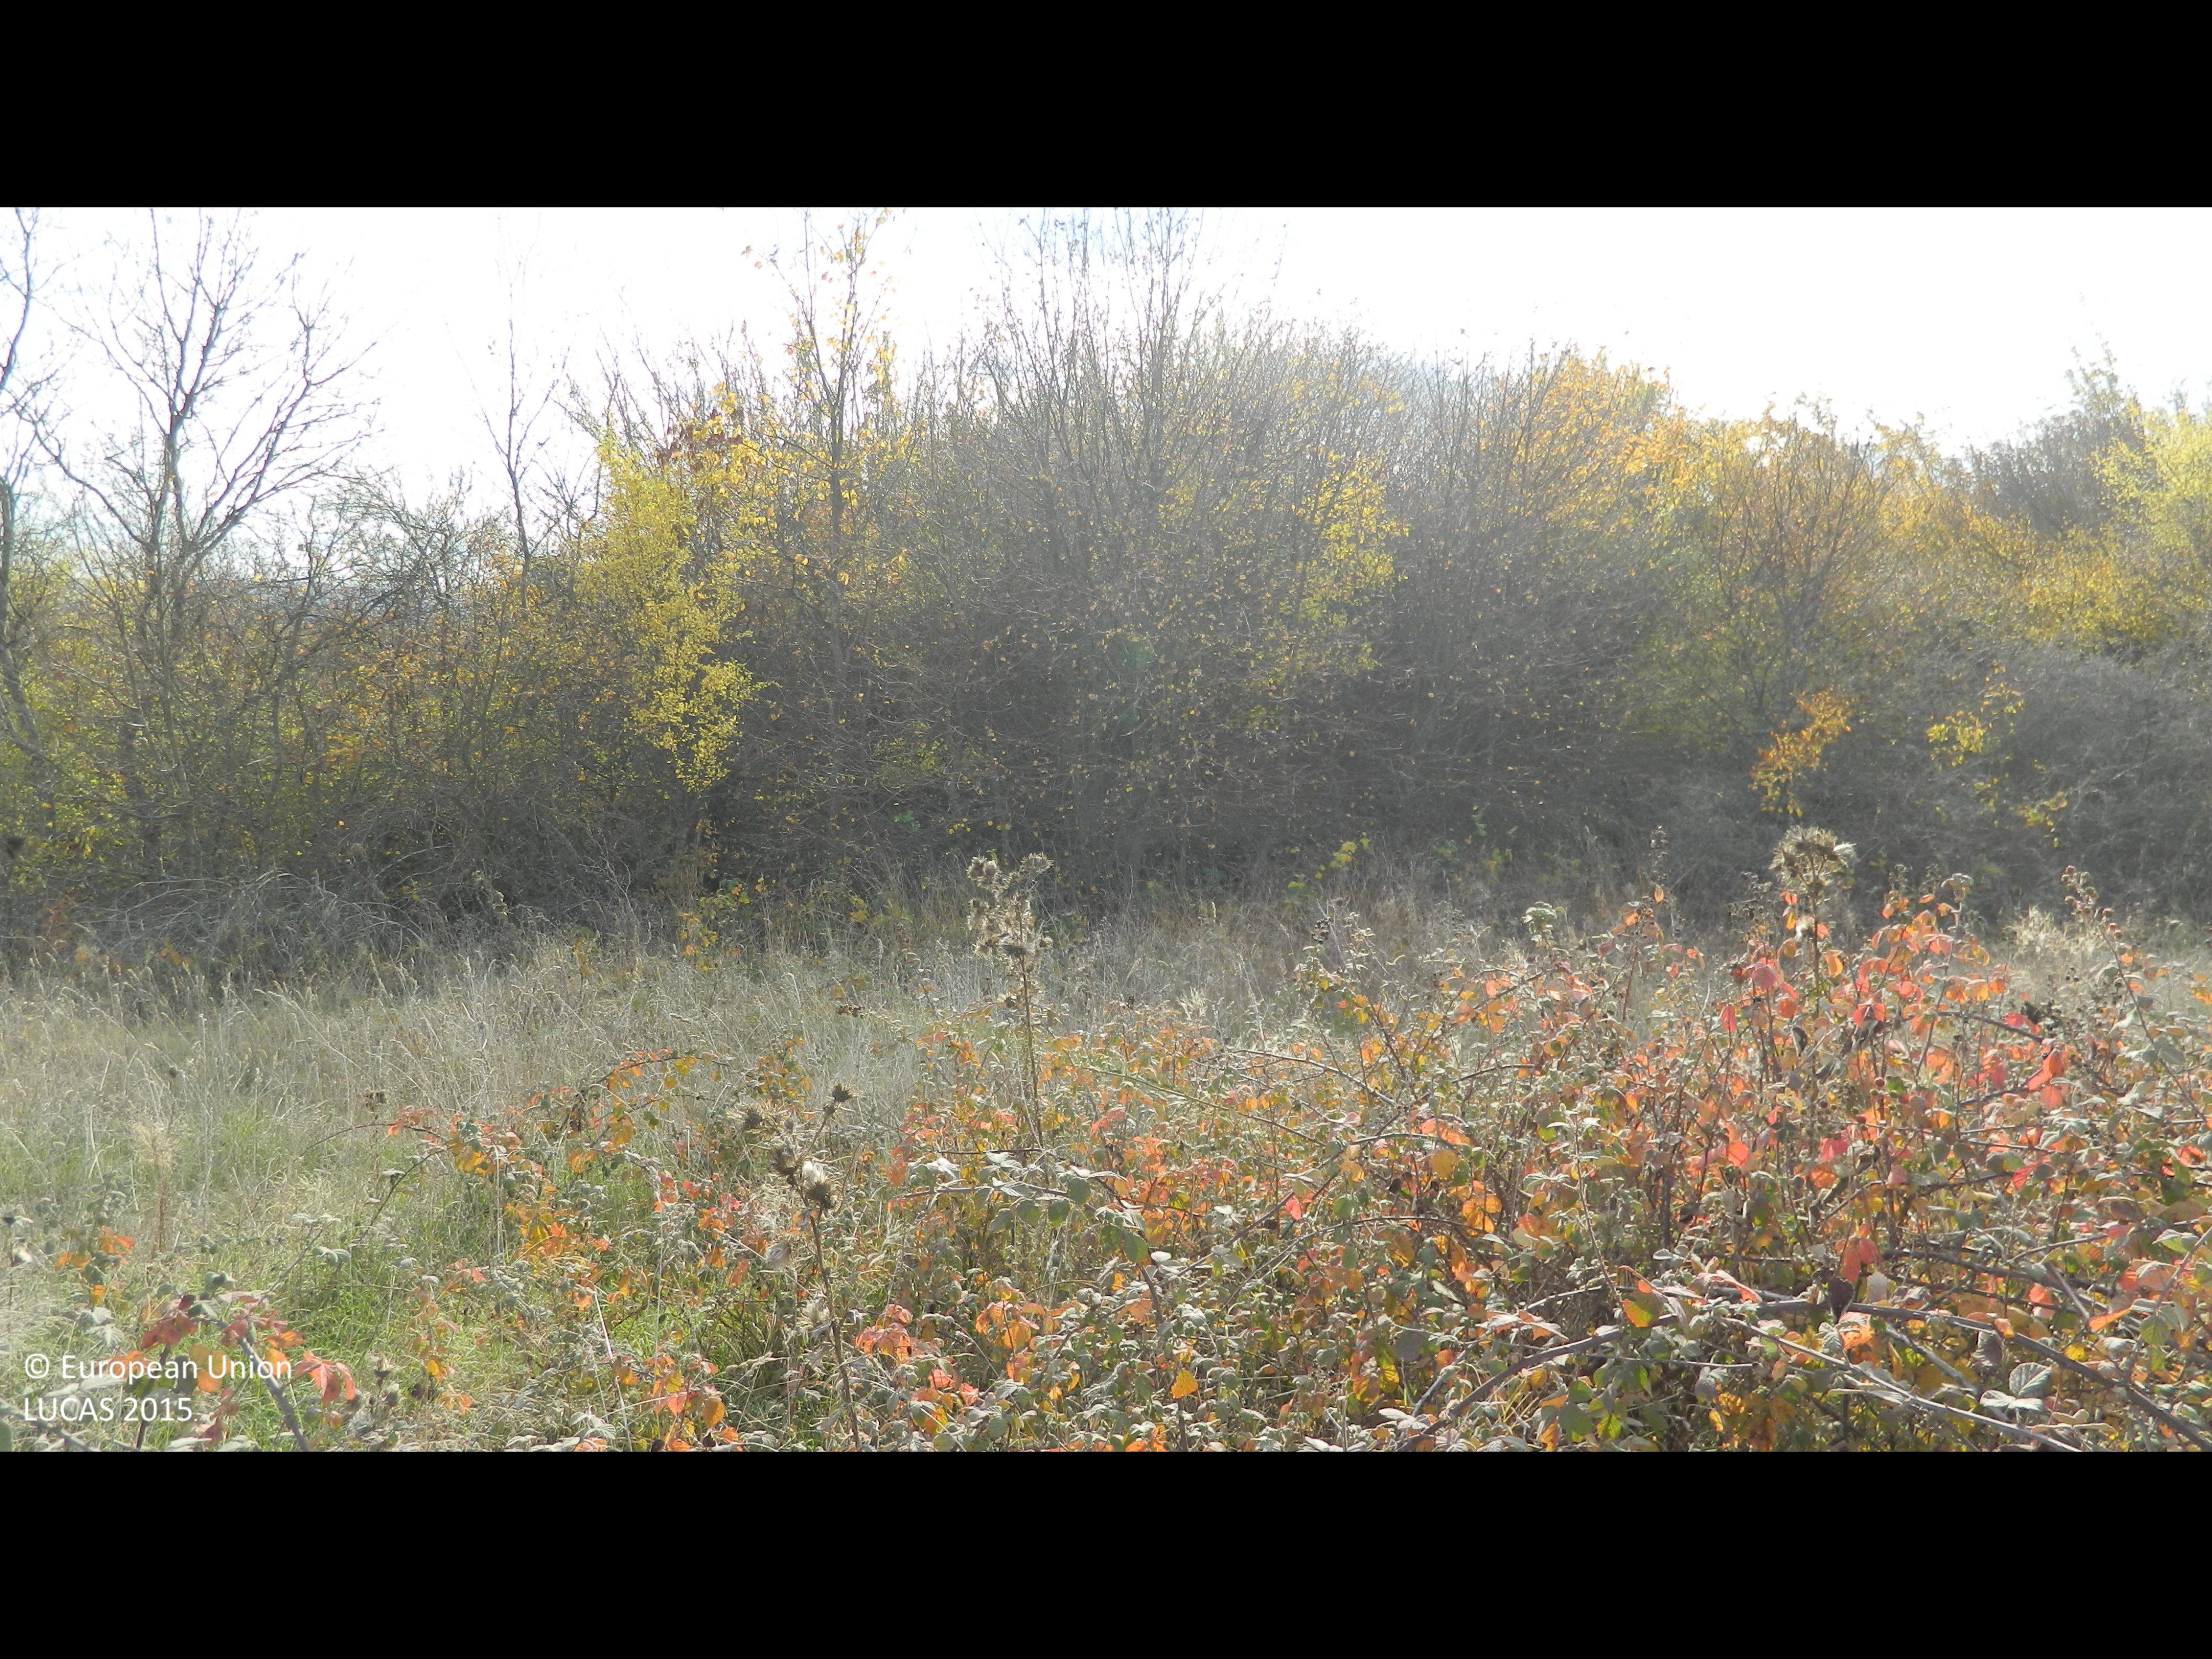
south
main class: Shrubland
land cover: Shrubland without tree cover
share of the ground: > 75 %
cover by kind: shrubs 50 %, herbaceous plants 50 %
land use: Semi-natural and natural areas not in use
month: November
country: BG
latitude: 41.4248
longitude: 26.0173
